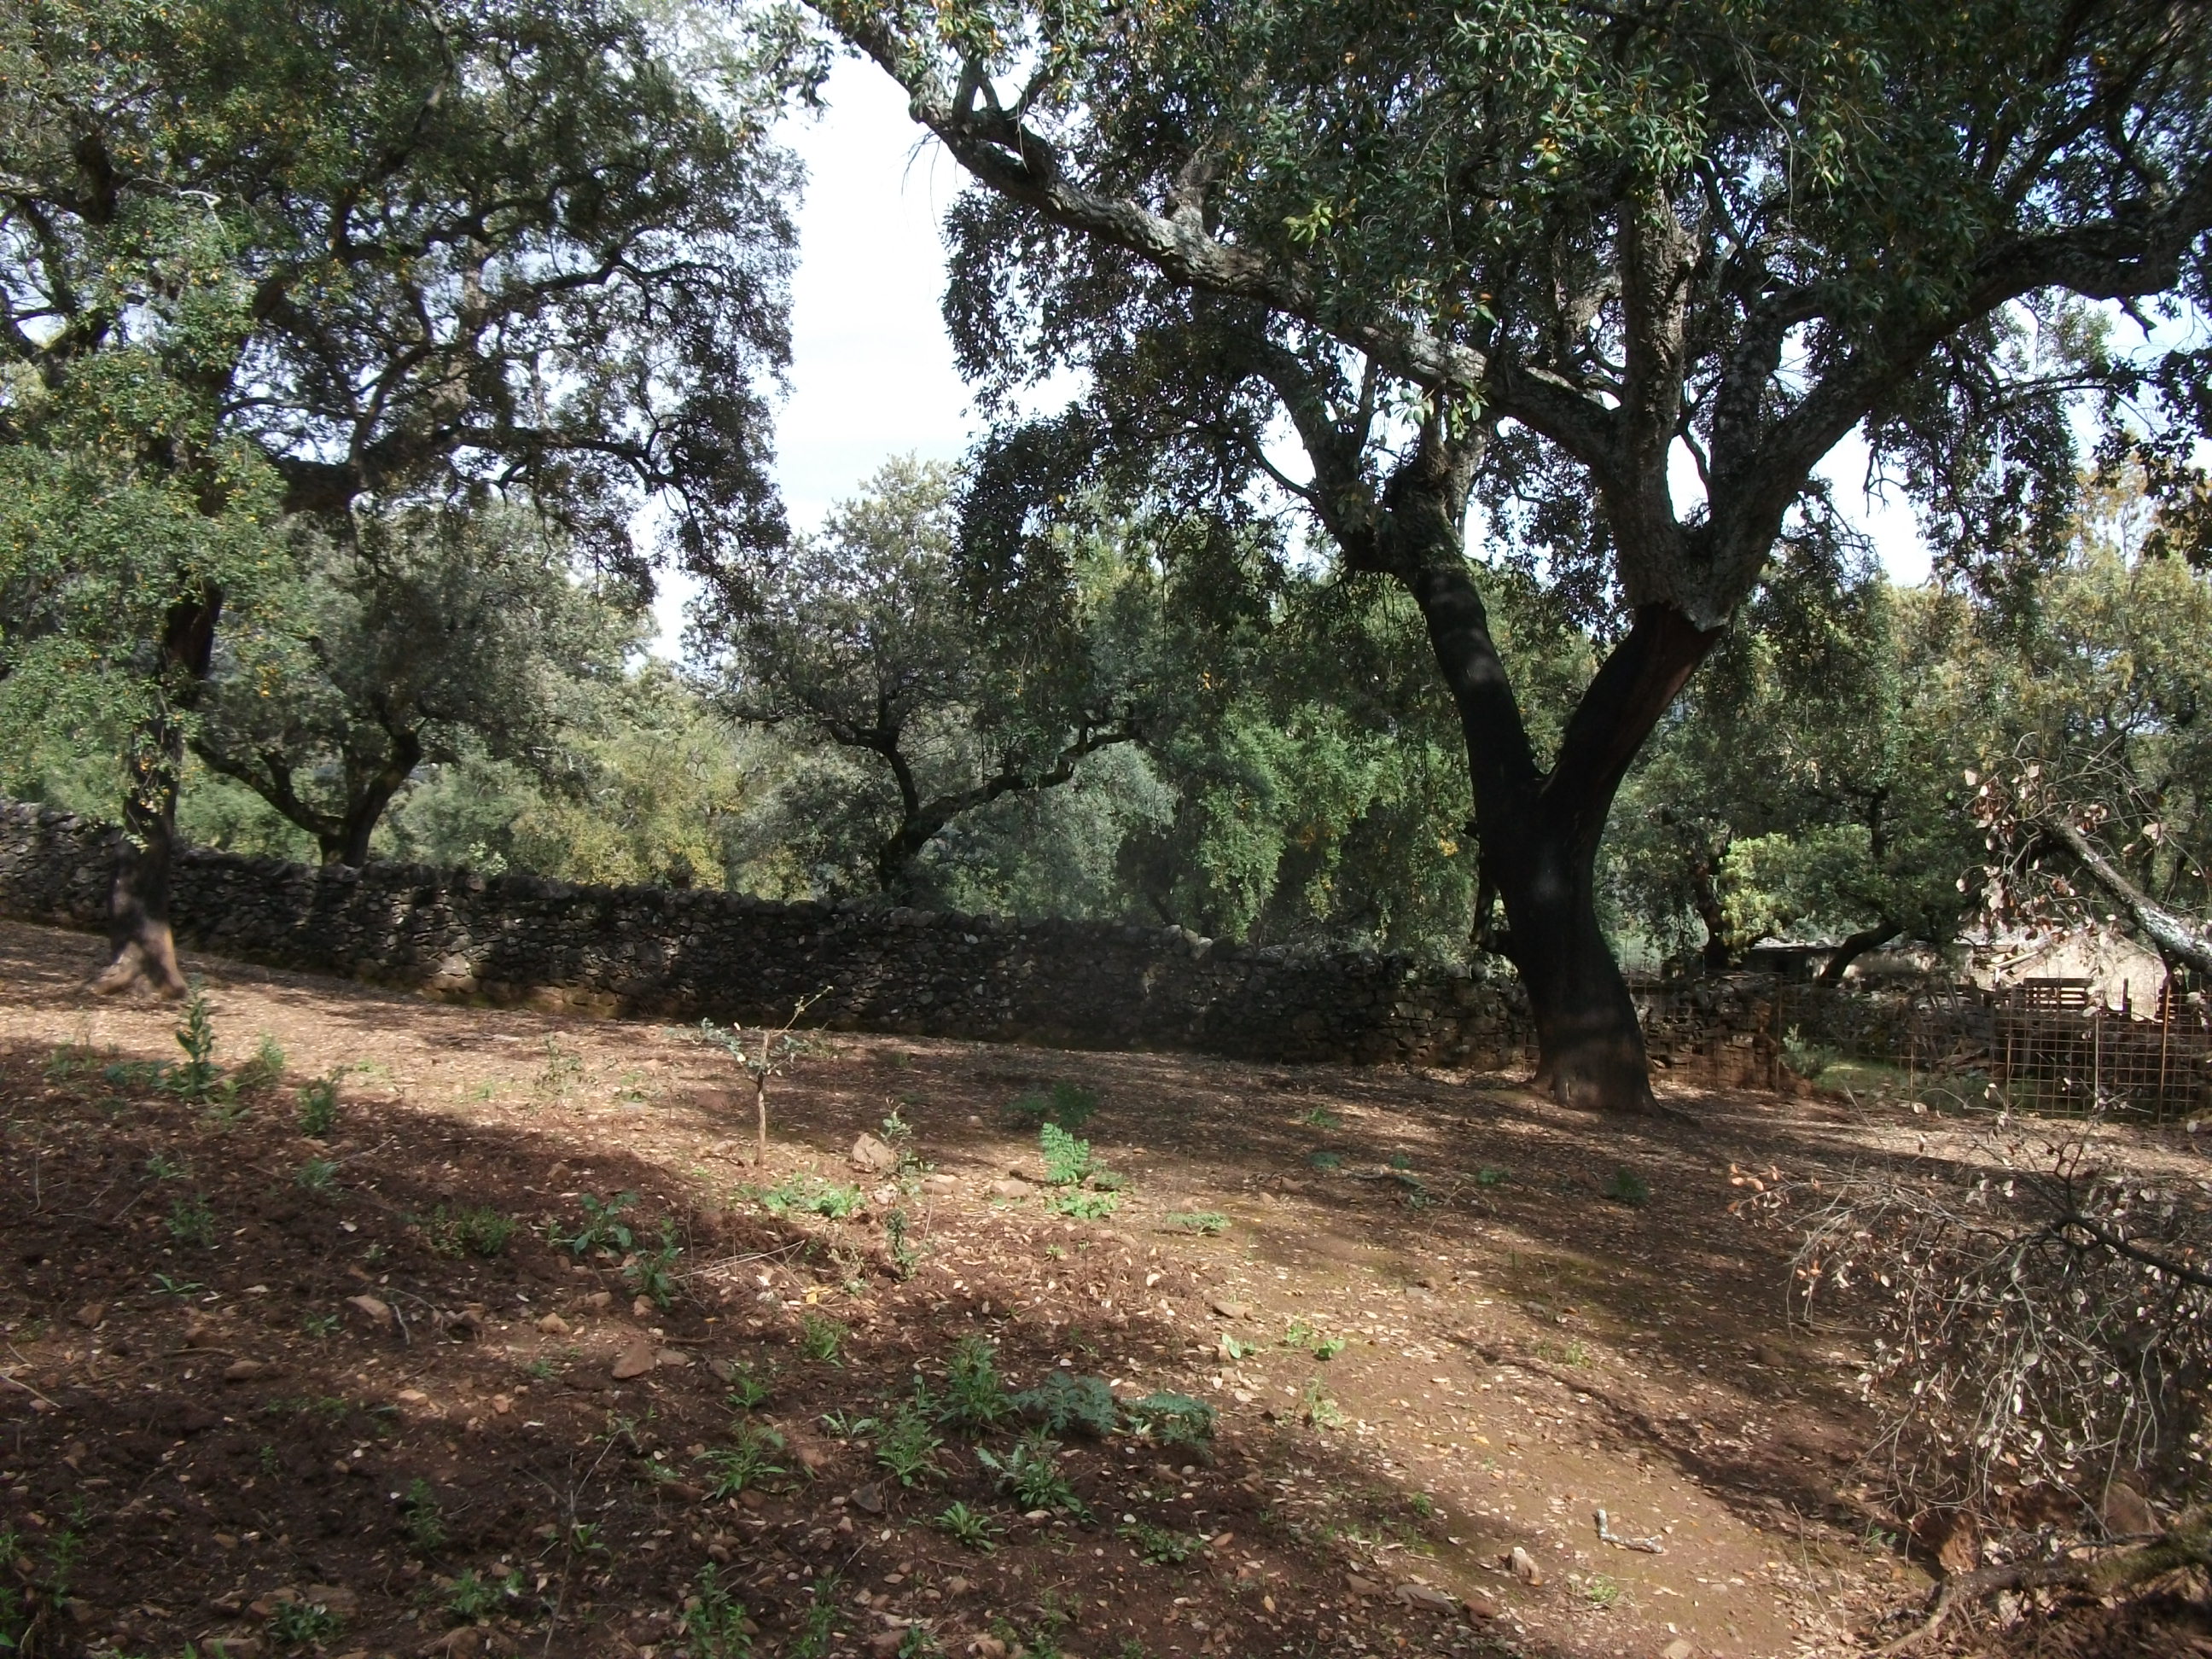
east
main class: Woodland
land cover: Broadleaved woodland
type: broadleaved evergreen forest
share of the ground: 50 - 75 %
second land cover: Spontaneously vegetated surfaces
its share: 10 - 25 %
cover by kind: broadleaved forest trees 80 %, herbaceous plants 10 %, unconsolidated bare surface 10 %
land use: Forestry
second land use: Agriculture (excluding fallow land and kitchen gardens)
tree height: > 5 m
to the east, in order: Broadleaved woodland; Spontaneously vegetated surfaces; Dry stone walls; Broadleaved woodland; Dry stone walls; Shruby margins; Broadleaved woodland; Grass margins; Tracks; Dry stone walls; Fences; Broadleaved woodland
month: April
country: ES
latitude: 37.8618
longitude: -6.5121
